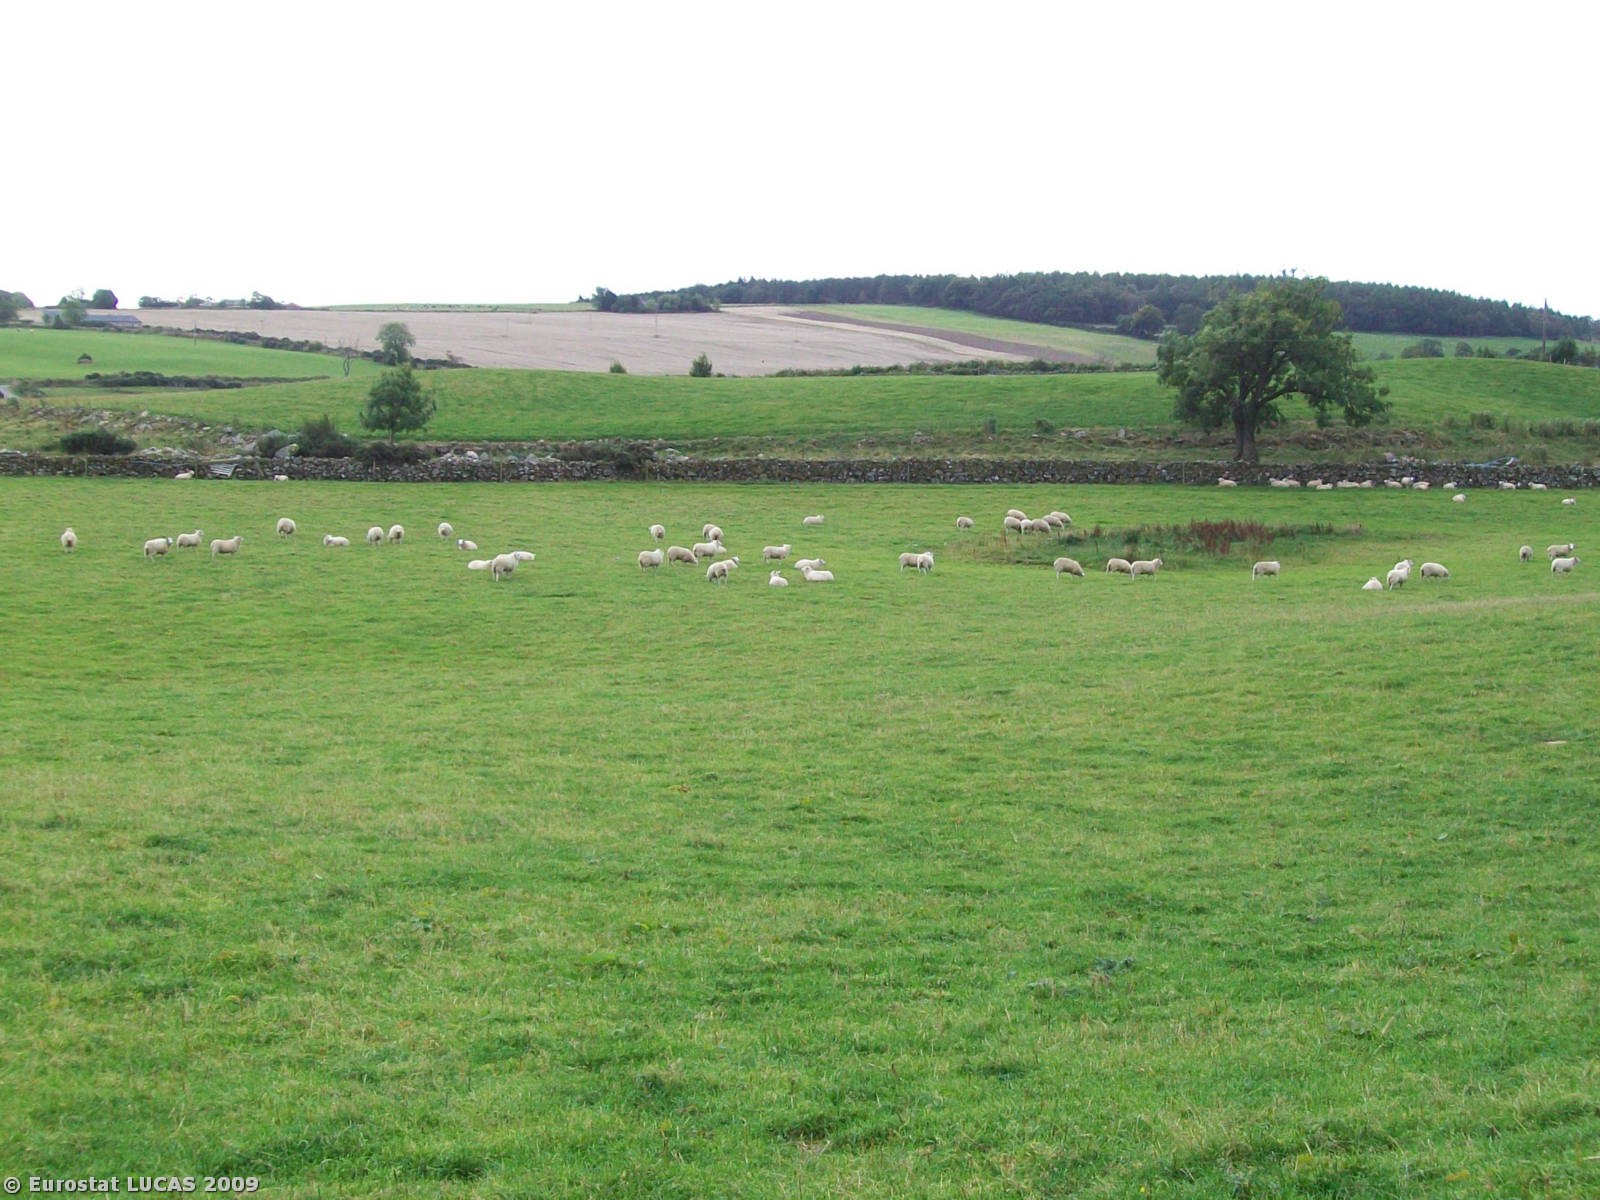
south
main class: Grassland
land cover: Grassland without tree/shrub cover
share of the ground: > 75 %
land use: Agriculture (excluding fallow land and kitchen gardens)
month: September
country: GB
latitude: 57.2500
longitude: -2.5011
